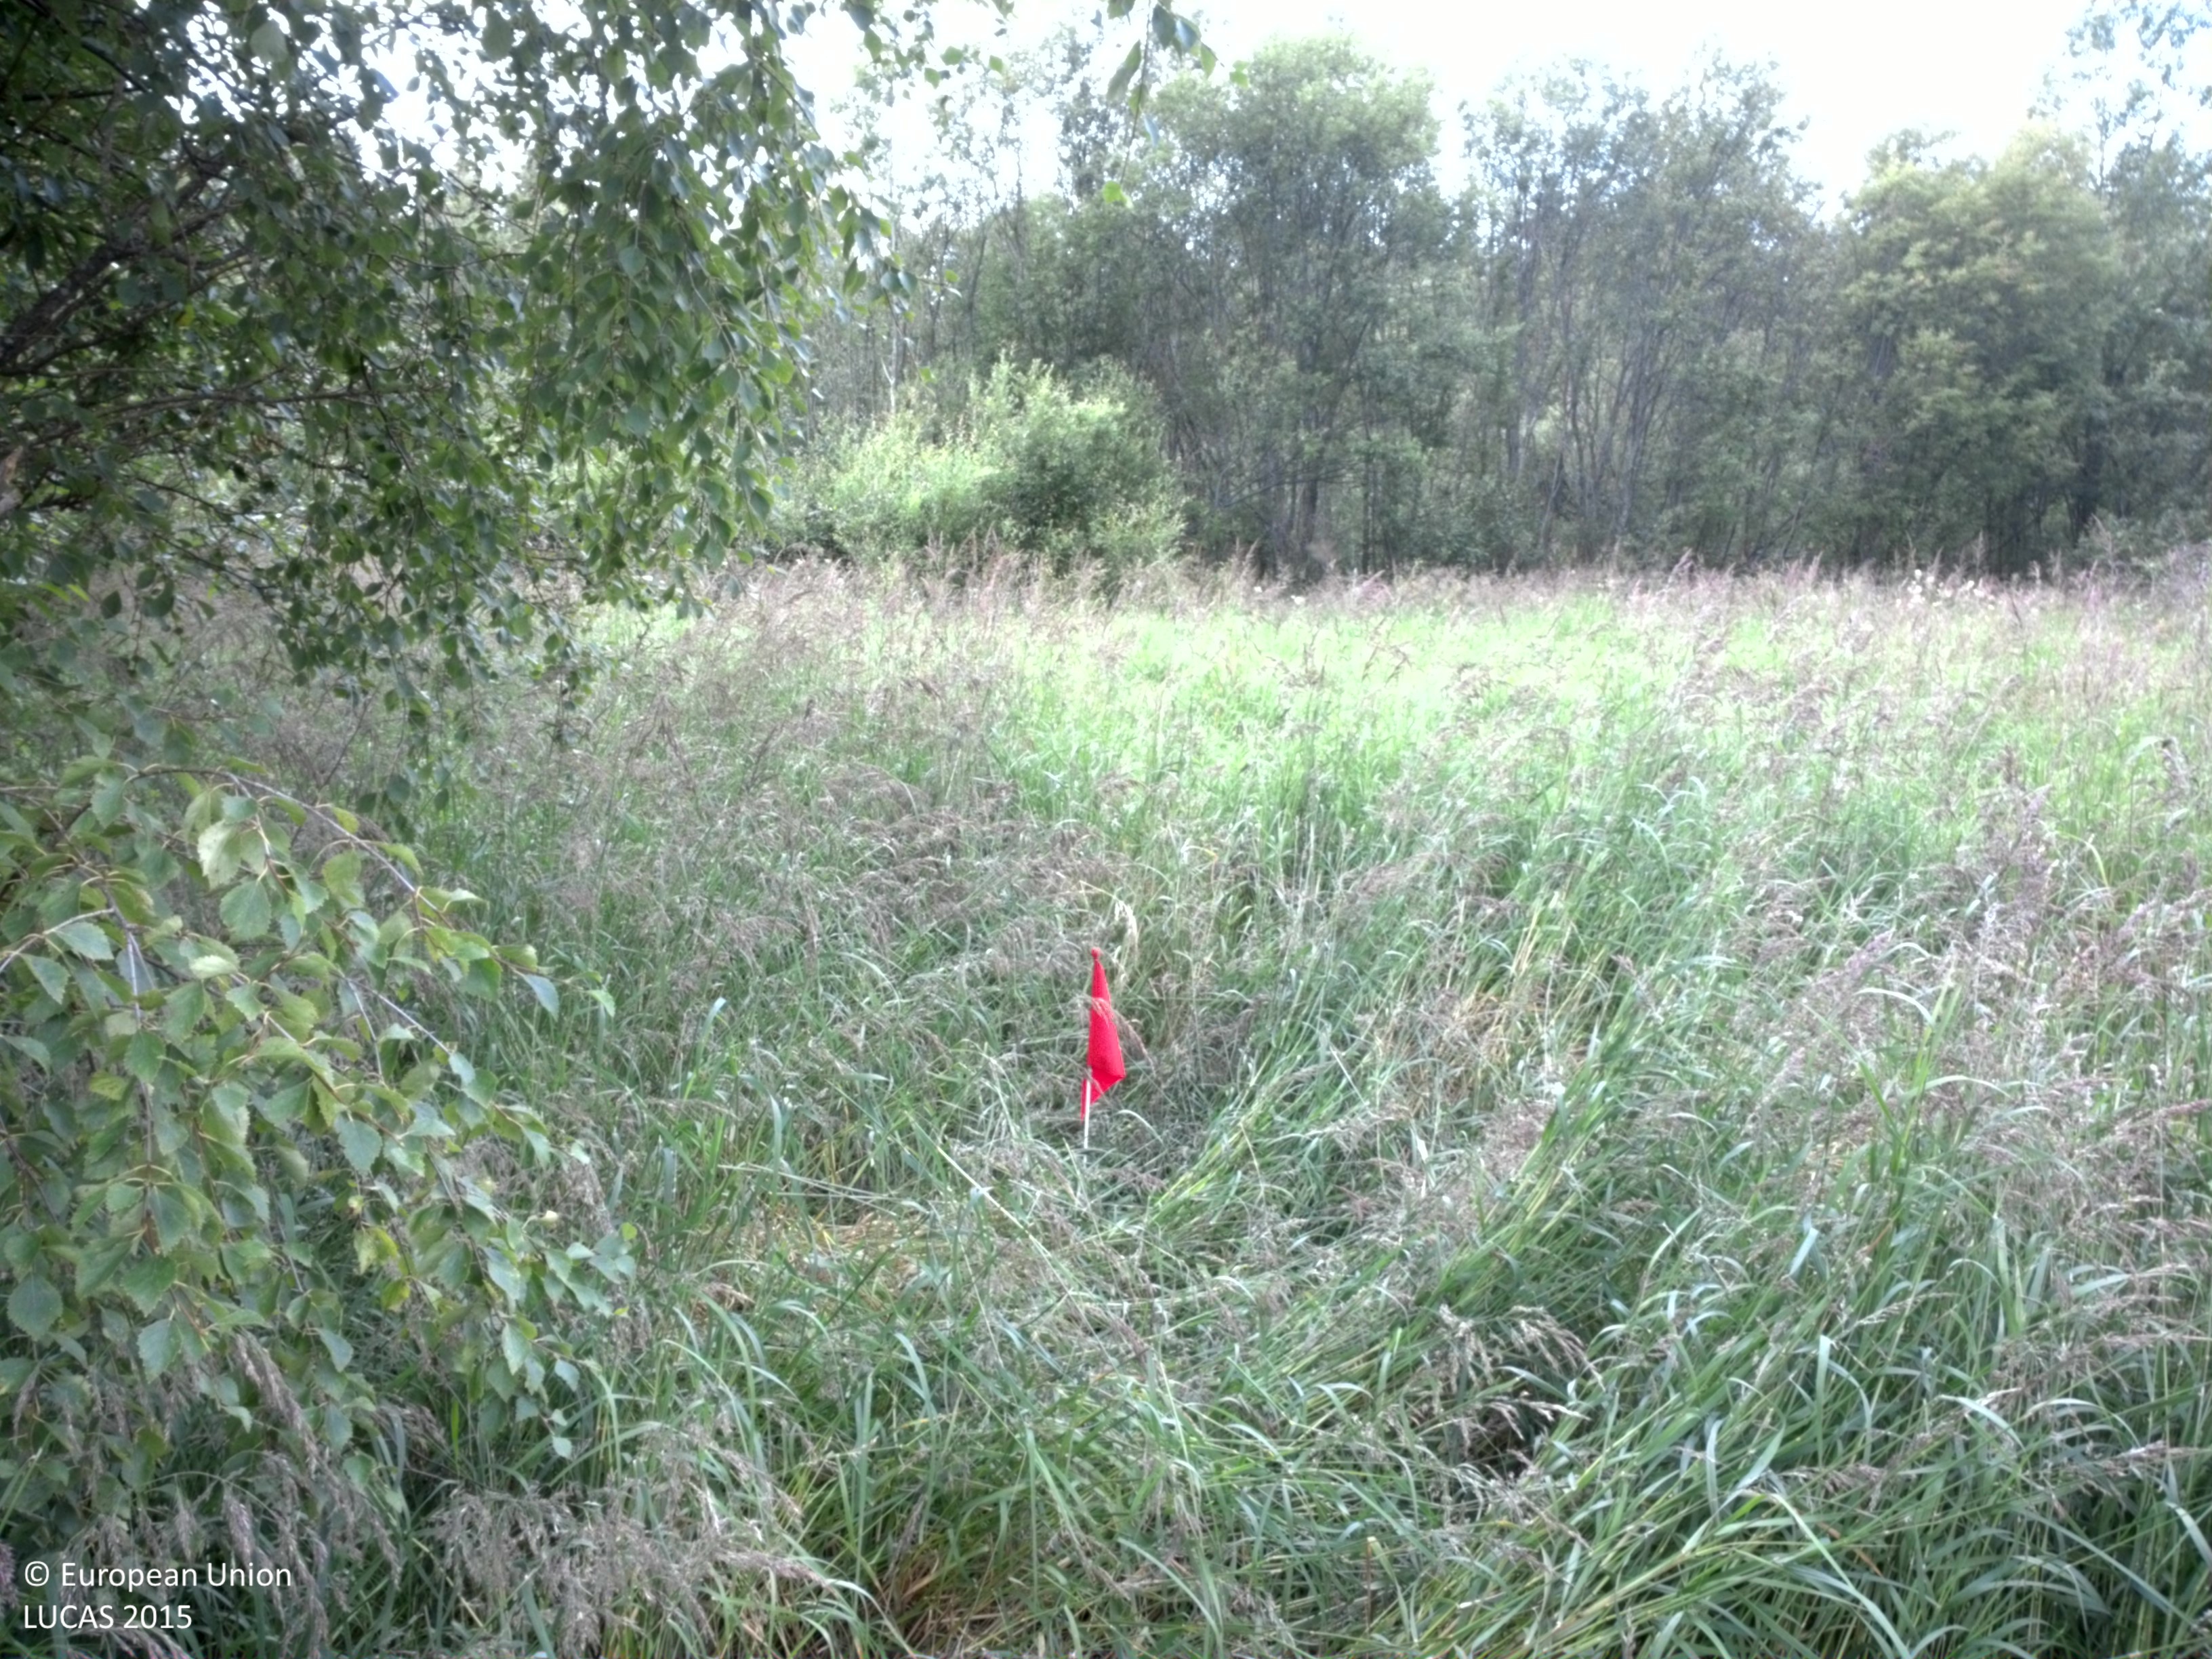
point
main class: Grassland
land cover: Grassland with sparse tree/shrub cover
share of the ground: > 75 %
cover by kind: herbaceous plants 95 %, broadleaved forest trees 5 %
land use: Agriculture (excluding fallow land and kitchen gardens)
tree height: > 5 m
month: August
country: SE
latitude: 64.6413
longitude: 20.9235
